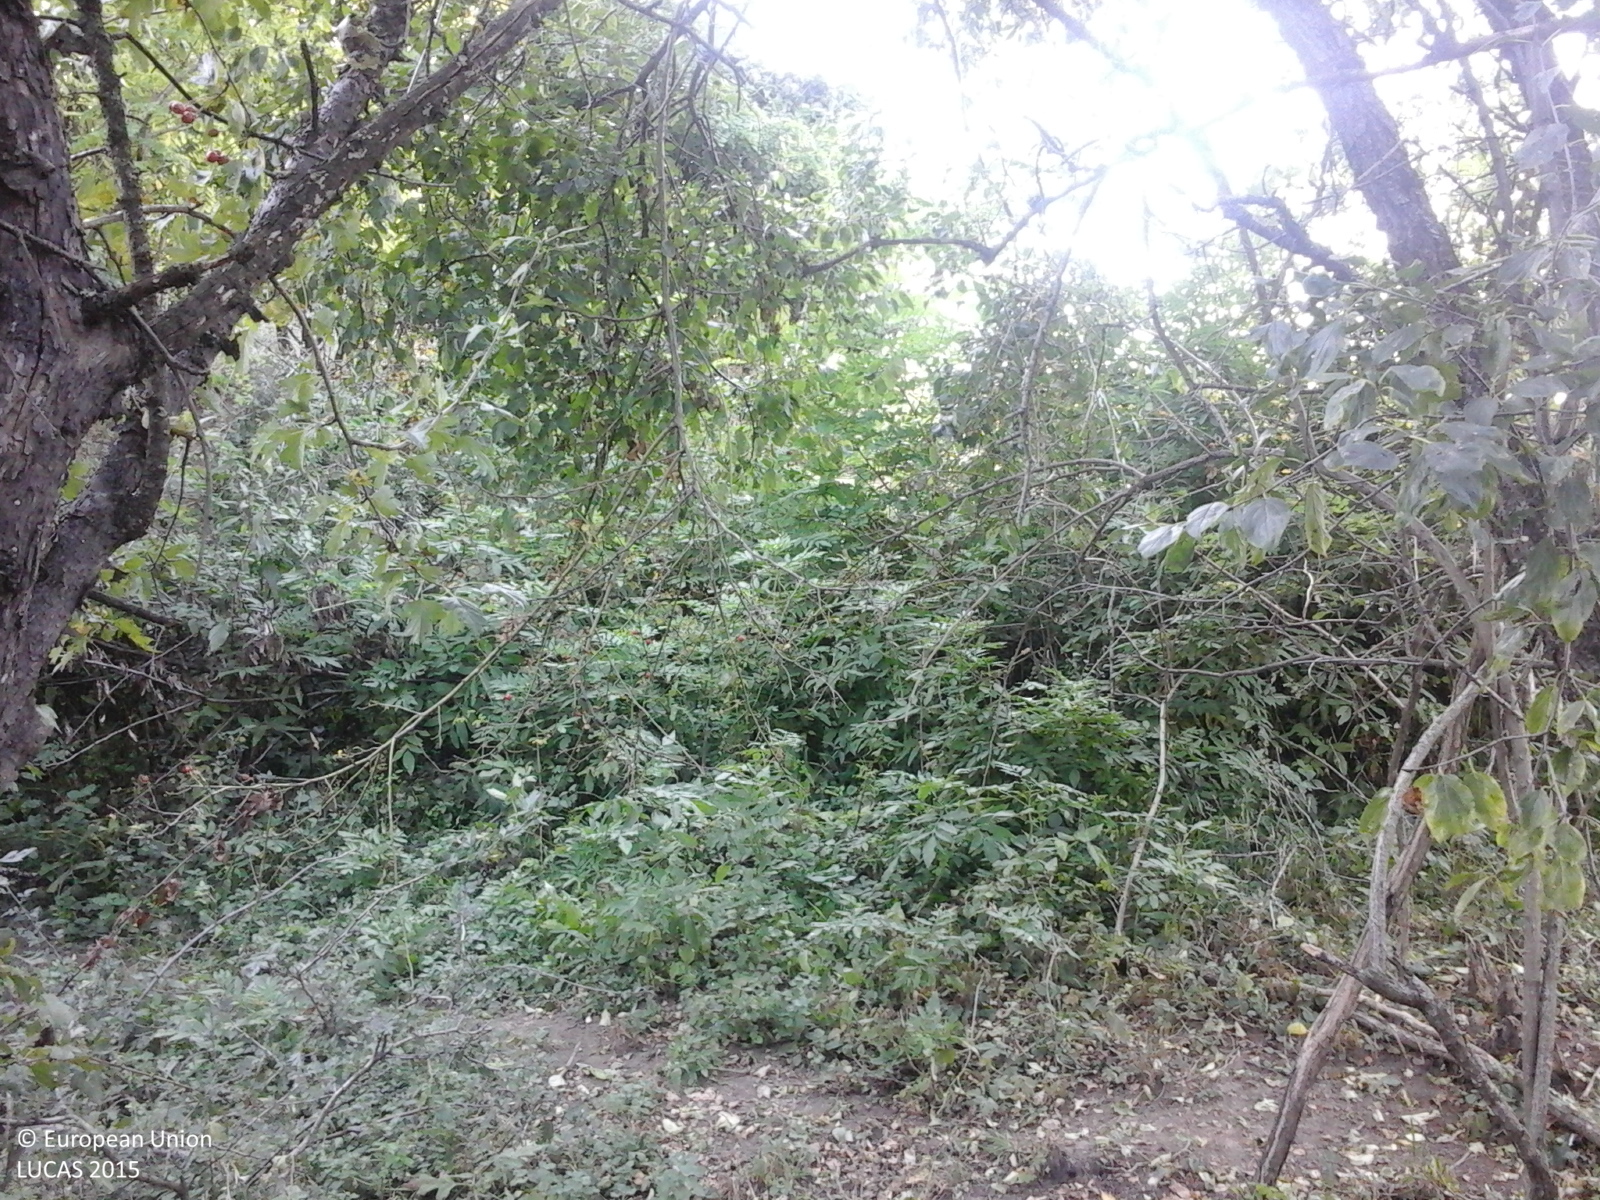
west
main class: Woodland
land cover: Broadleaved woodland
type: thermophilous deciduous forest
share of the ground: > 75 %
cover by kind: broadleaved forest trees 100 %
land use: Forestry
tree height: > 5 m
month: September
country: RO
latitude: 46.7359
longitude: 24.4435
